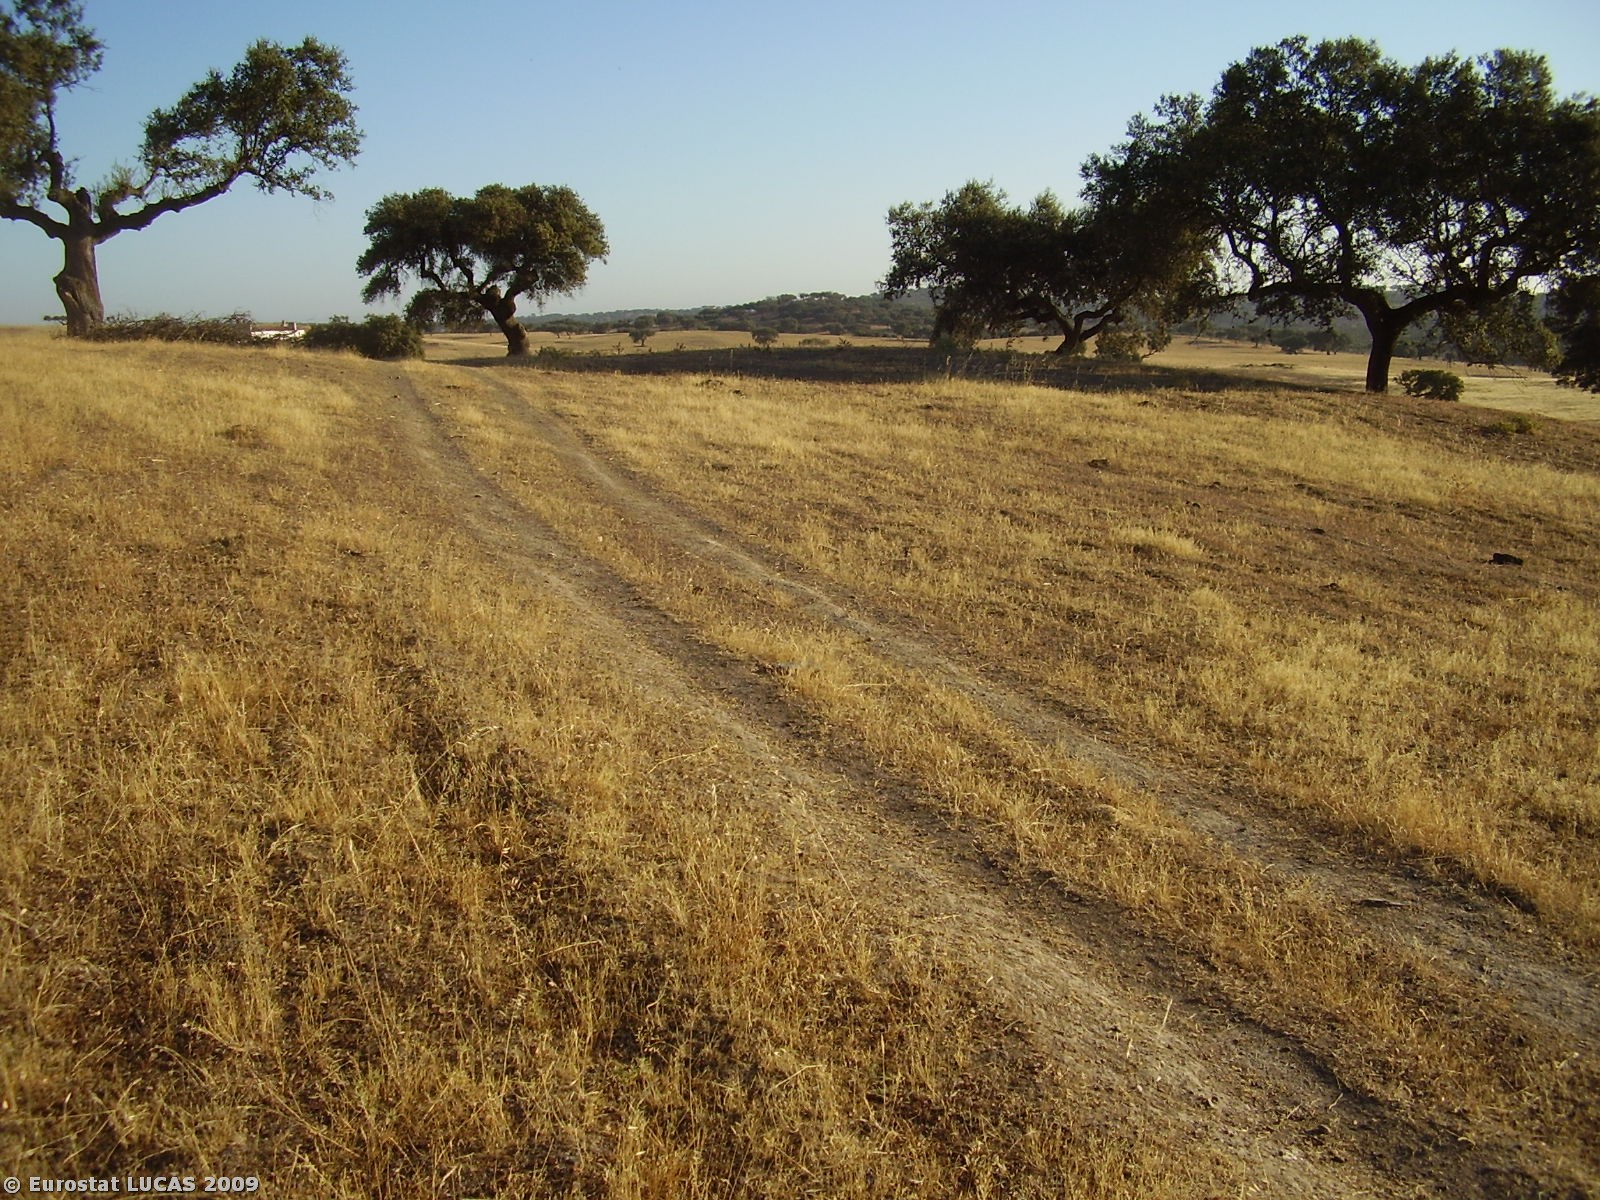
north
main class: Grassland
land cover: Grassland with sparse tree/shrub cover
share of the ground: > 75 %
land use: Agriculture (excluding fallow land and kitchen gardens)
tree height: > 5 m
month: July
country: PT
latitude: 38.6443
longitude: -7.2951
